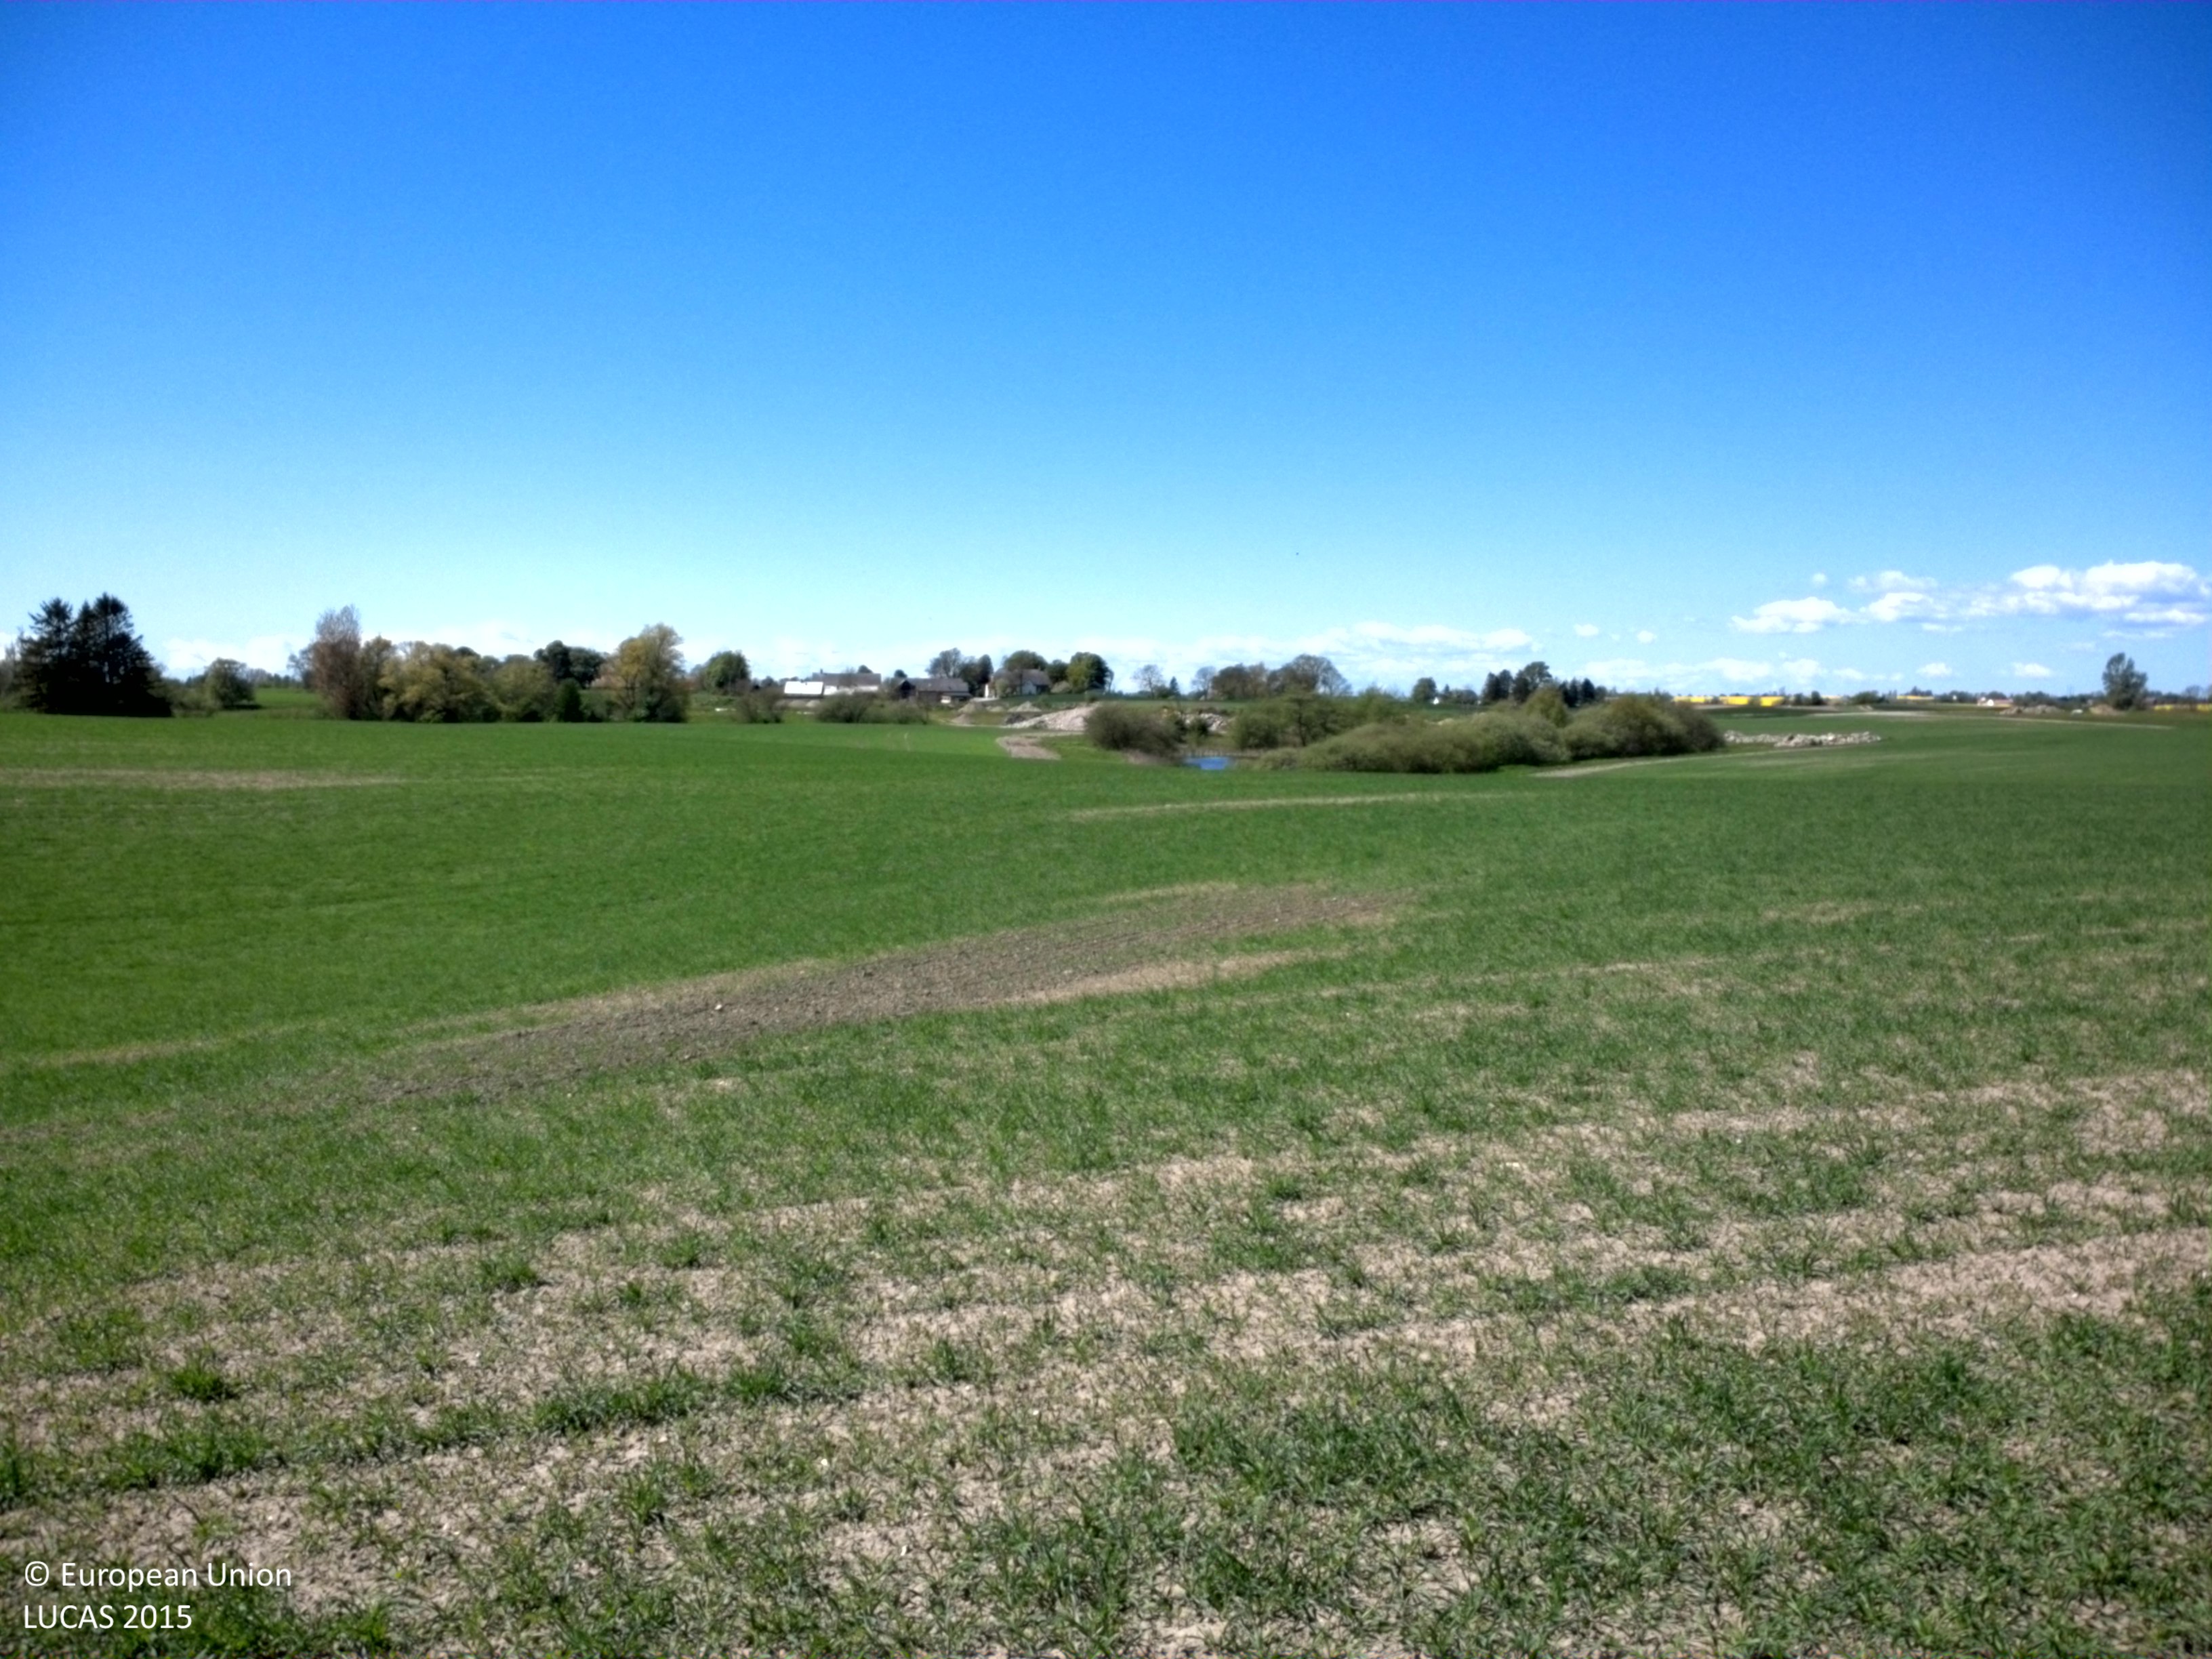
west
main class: Cropland
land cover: Barley
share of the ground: 50 - 75 %
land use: Agriculture (excluding fallow land and kitchen gardens)
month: May
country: SE
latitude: 55.5023
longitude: 13.1169
